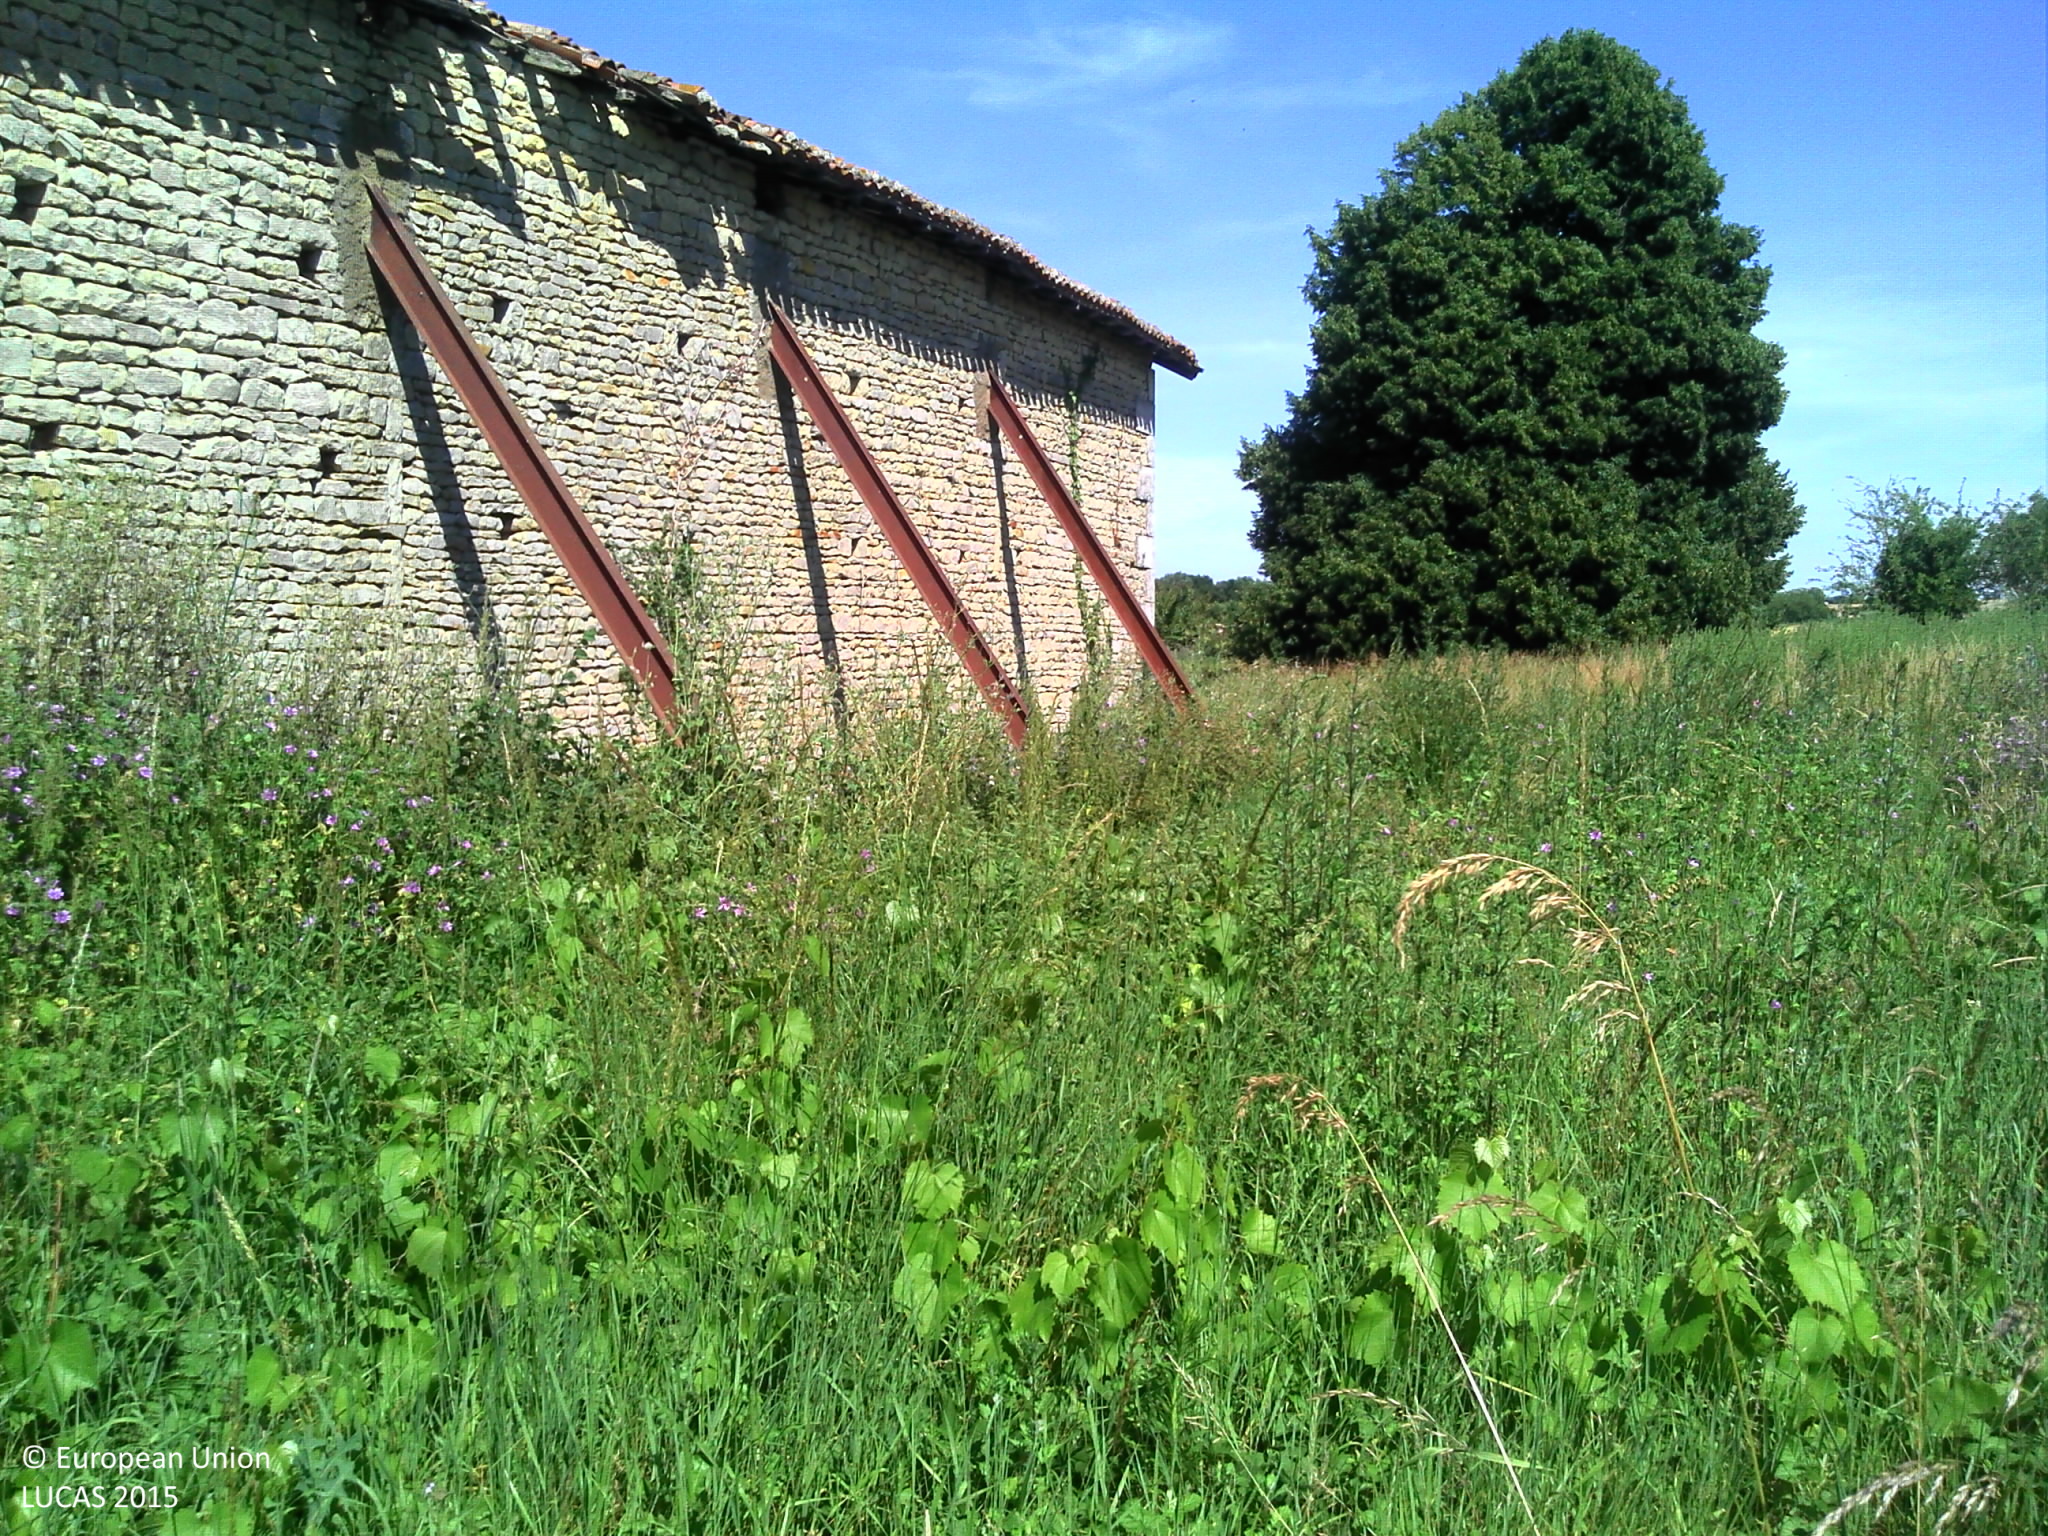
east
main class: Grassland
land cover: Spontaneously vegetated surfaces
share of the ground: > 75 %
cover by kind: herbaceous plants 100 %
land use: Semi-natural and natural areas not in use
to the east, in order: Spontaneously vegetated surfaces; Artificial constructions in urban areas; Spontaneously vegetated surfaces; Grassland with sparse tree/shrub cover; Grass margins; Tracks; Grass margins; Fences; Single bushes/trees; Shrubland without tree cover; Spontaneously vegetated surfaces; Fences; Grassland without tree/shrub cover; Fences; Managed hedges; Grass margins
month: June
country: FR
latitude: 46.8726
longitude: 0.1246
